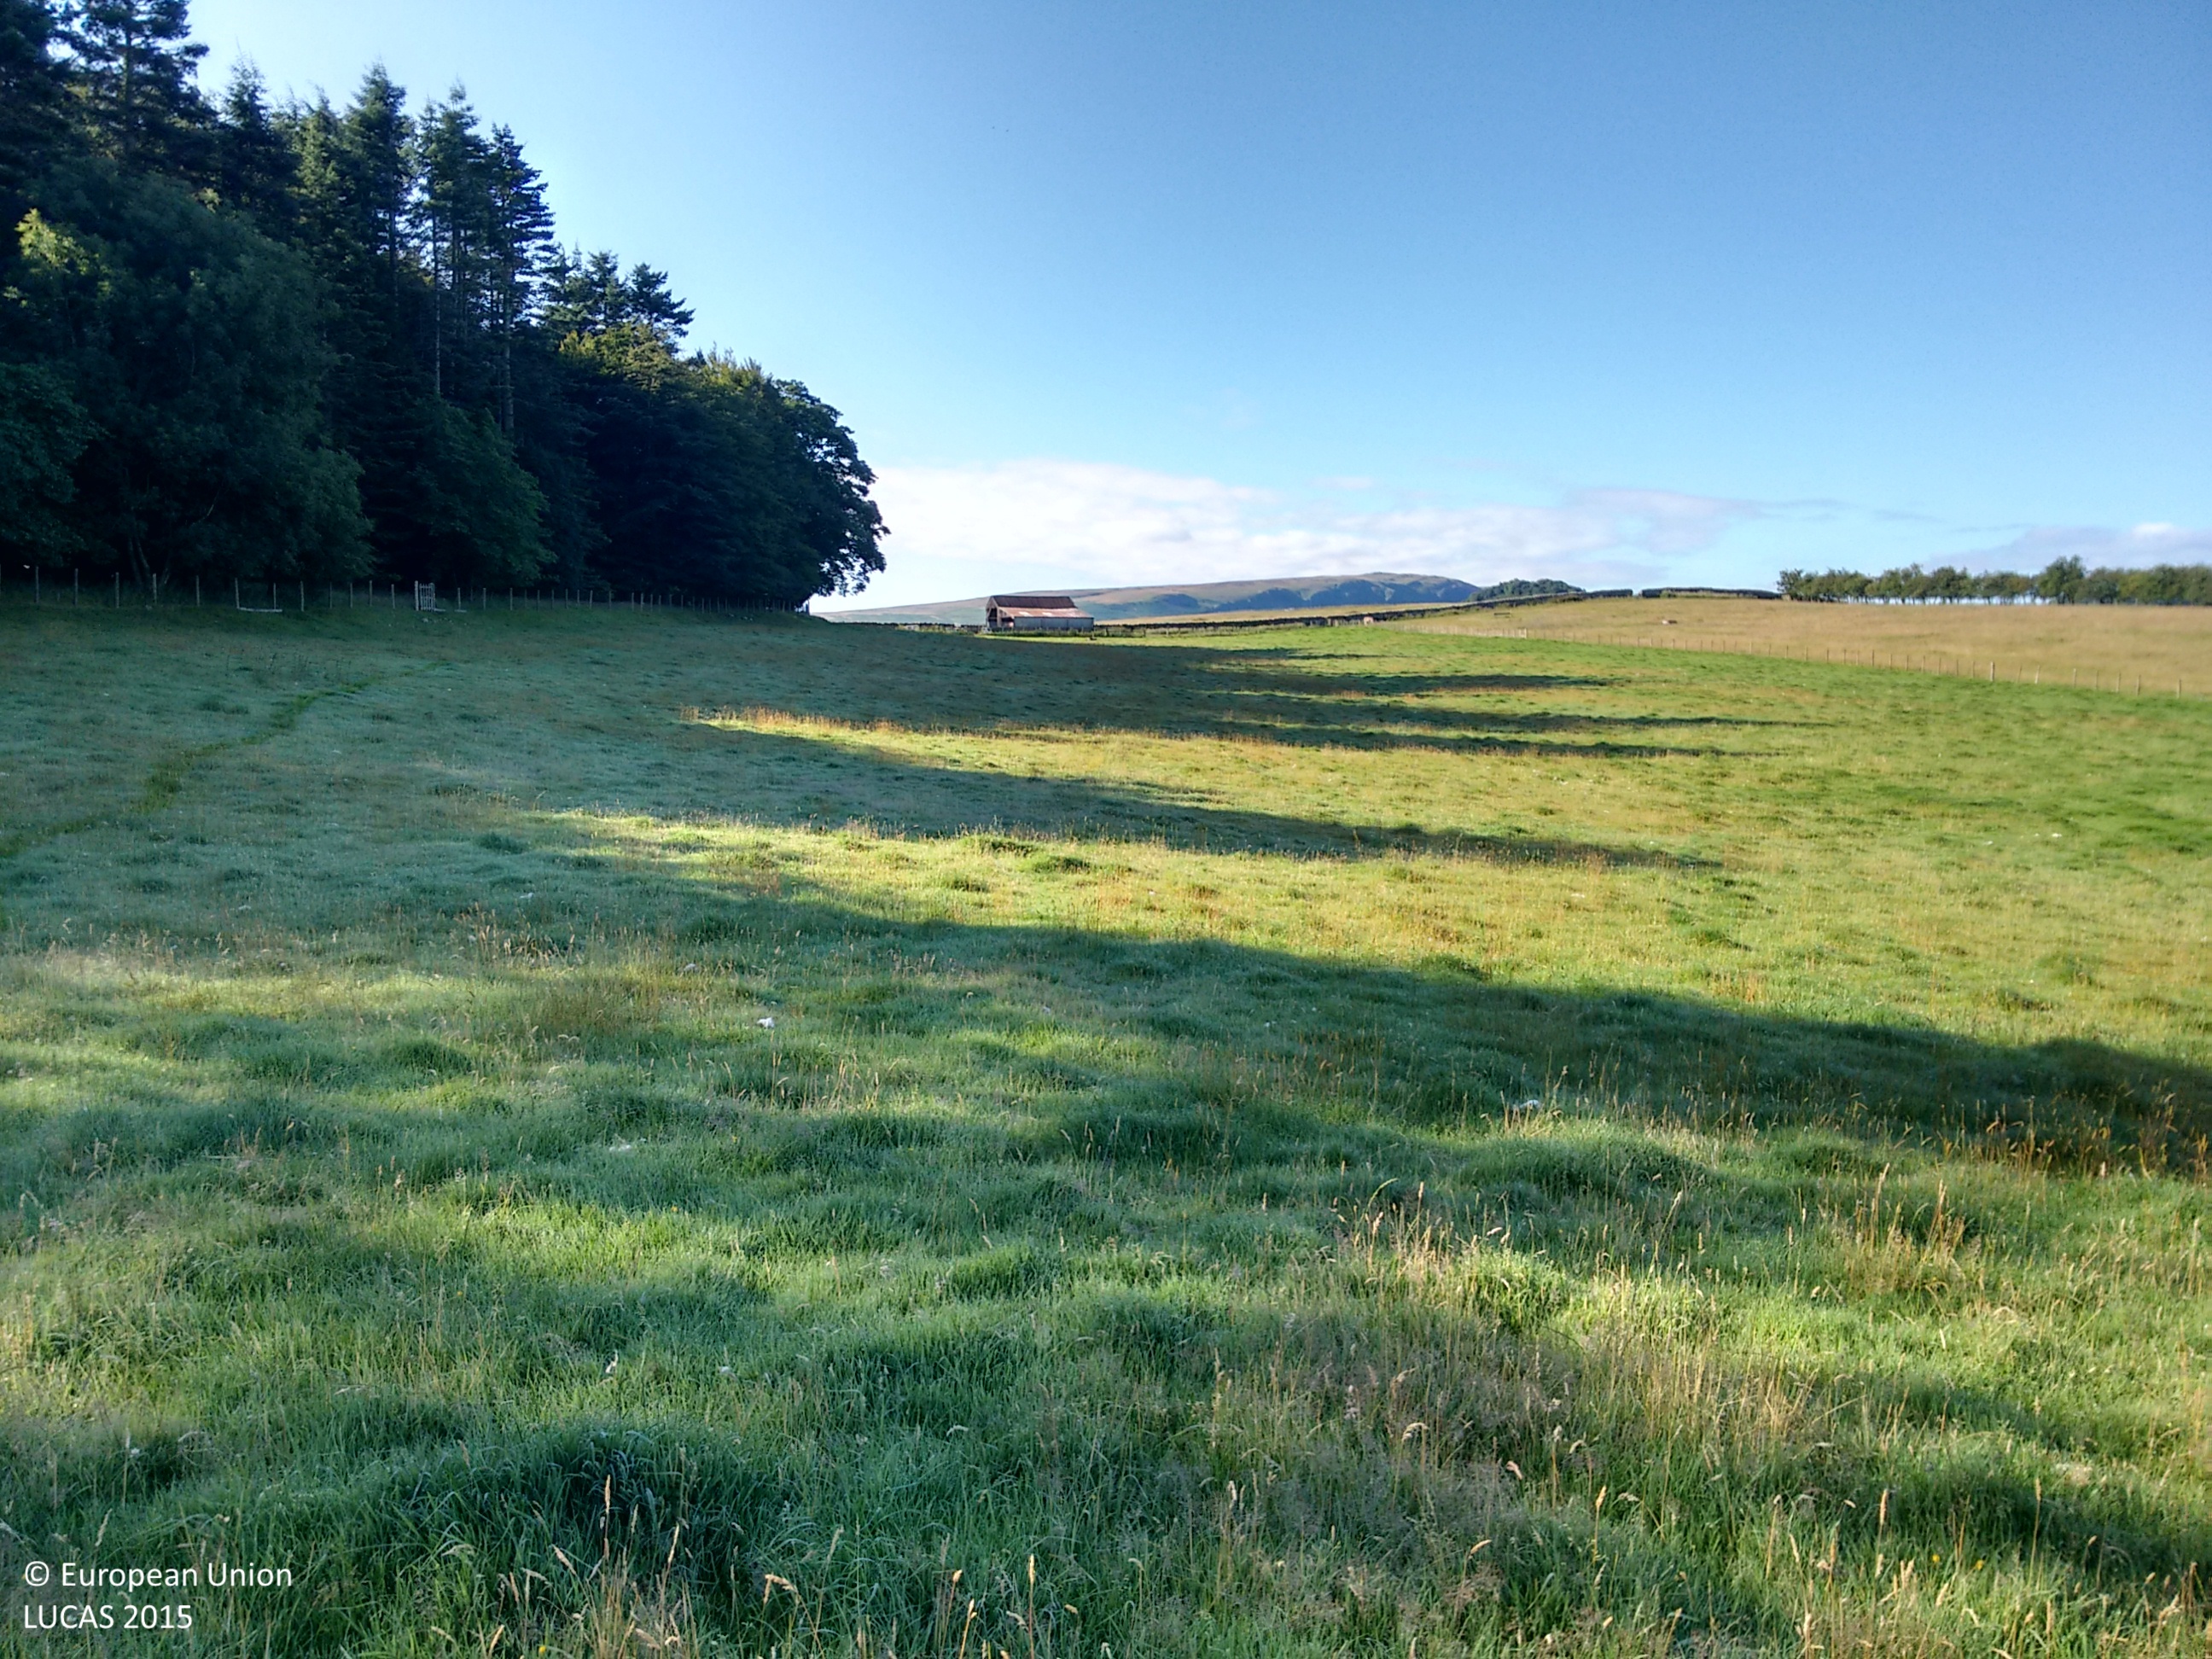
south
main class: Grassland
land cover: Grassland without tree/shrub cover
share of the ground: > 75 %
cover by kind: herbaceous plants 100 %
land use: Agriculture (excluding fallow land and kitchen gardens)
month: August
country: GB
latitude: 54.6302
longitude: -2.8178
